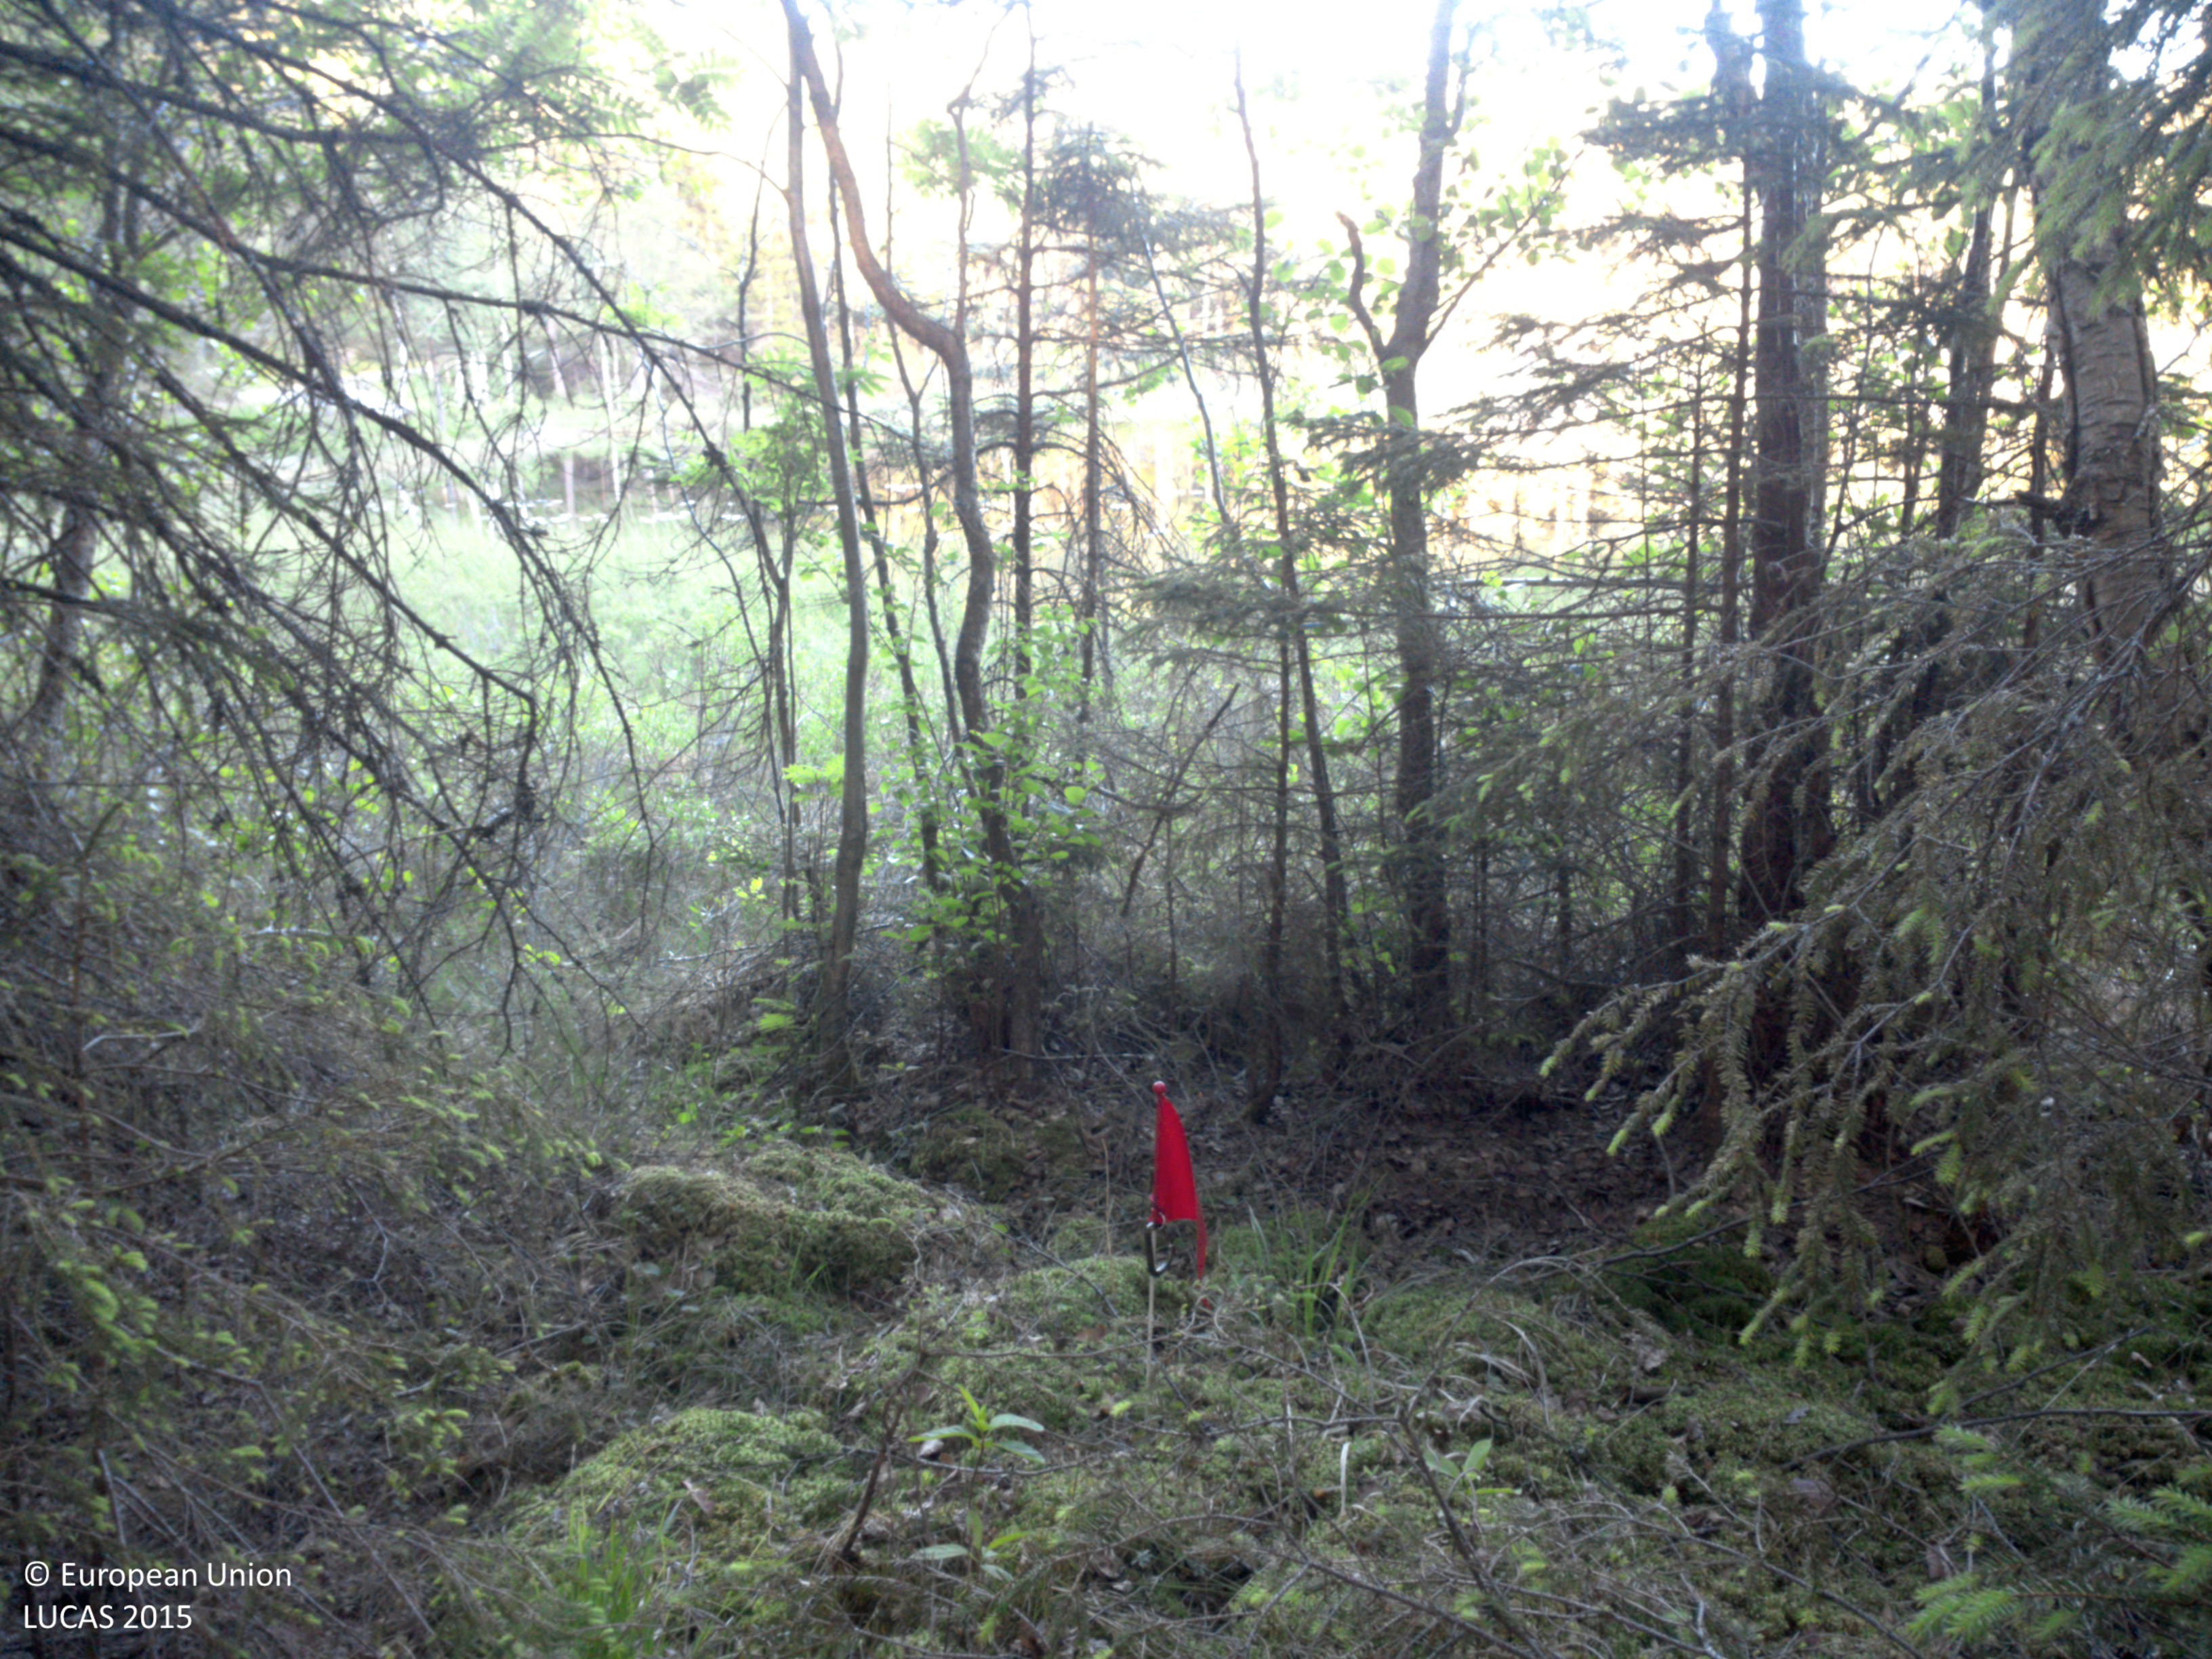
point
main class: Woodland
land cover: Spruce dominated mixed woodland
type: boreal forest
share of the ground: > 75 %
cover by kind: coniferous forest trees 65 %, broadleaved forest trees 25 %, herbaceous plants 5 %, lichens and mosses 5 %
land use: Forestry
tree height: > 5 m
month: June
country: SE
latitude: 59.1757
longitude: 12.0421
